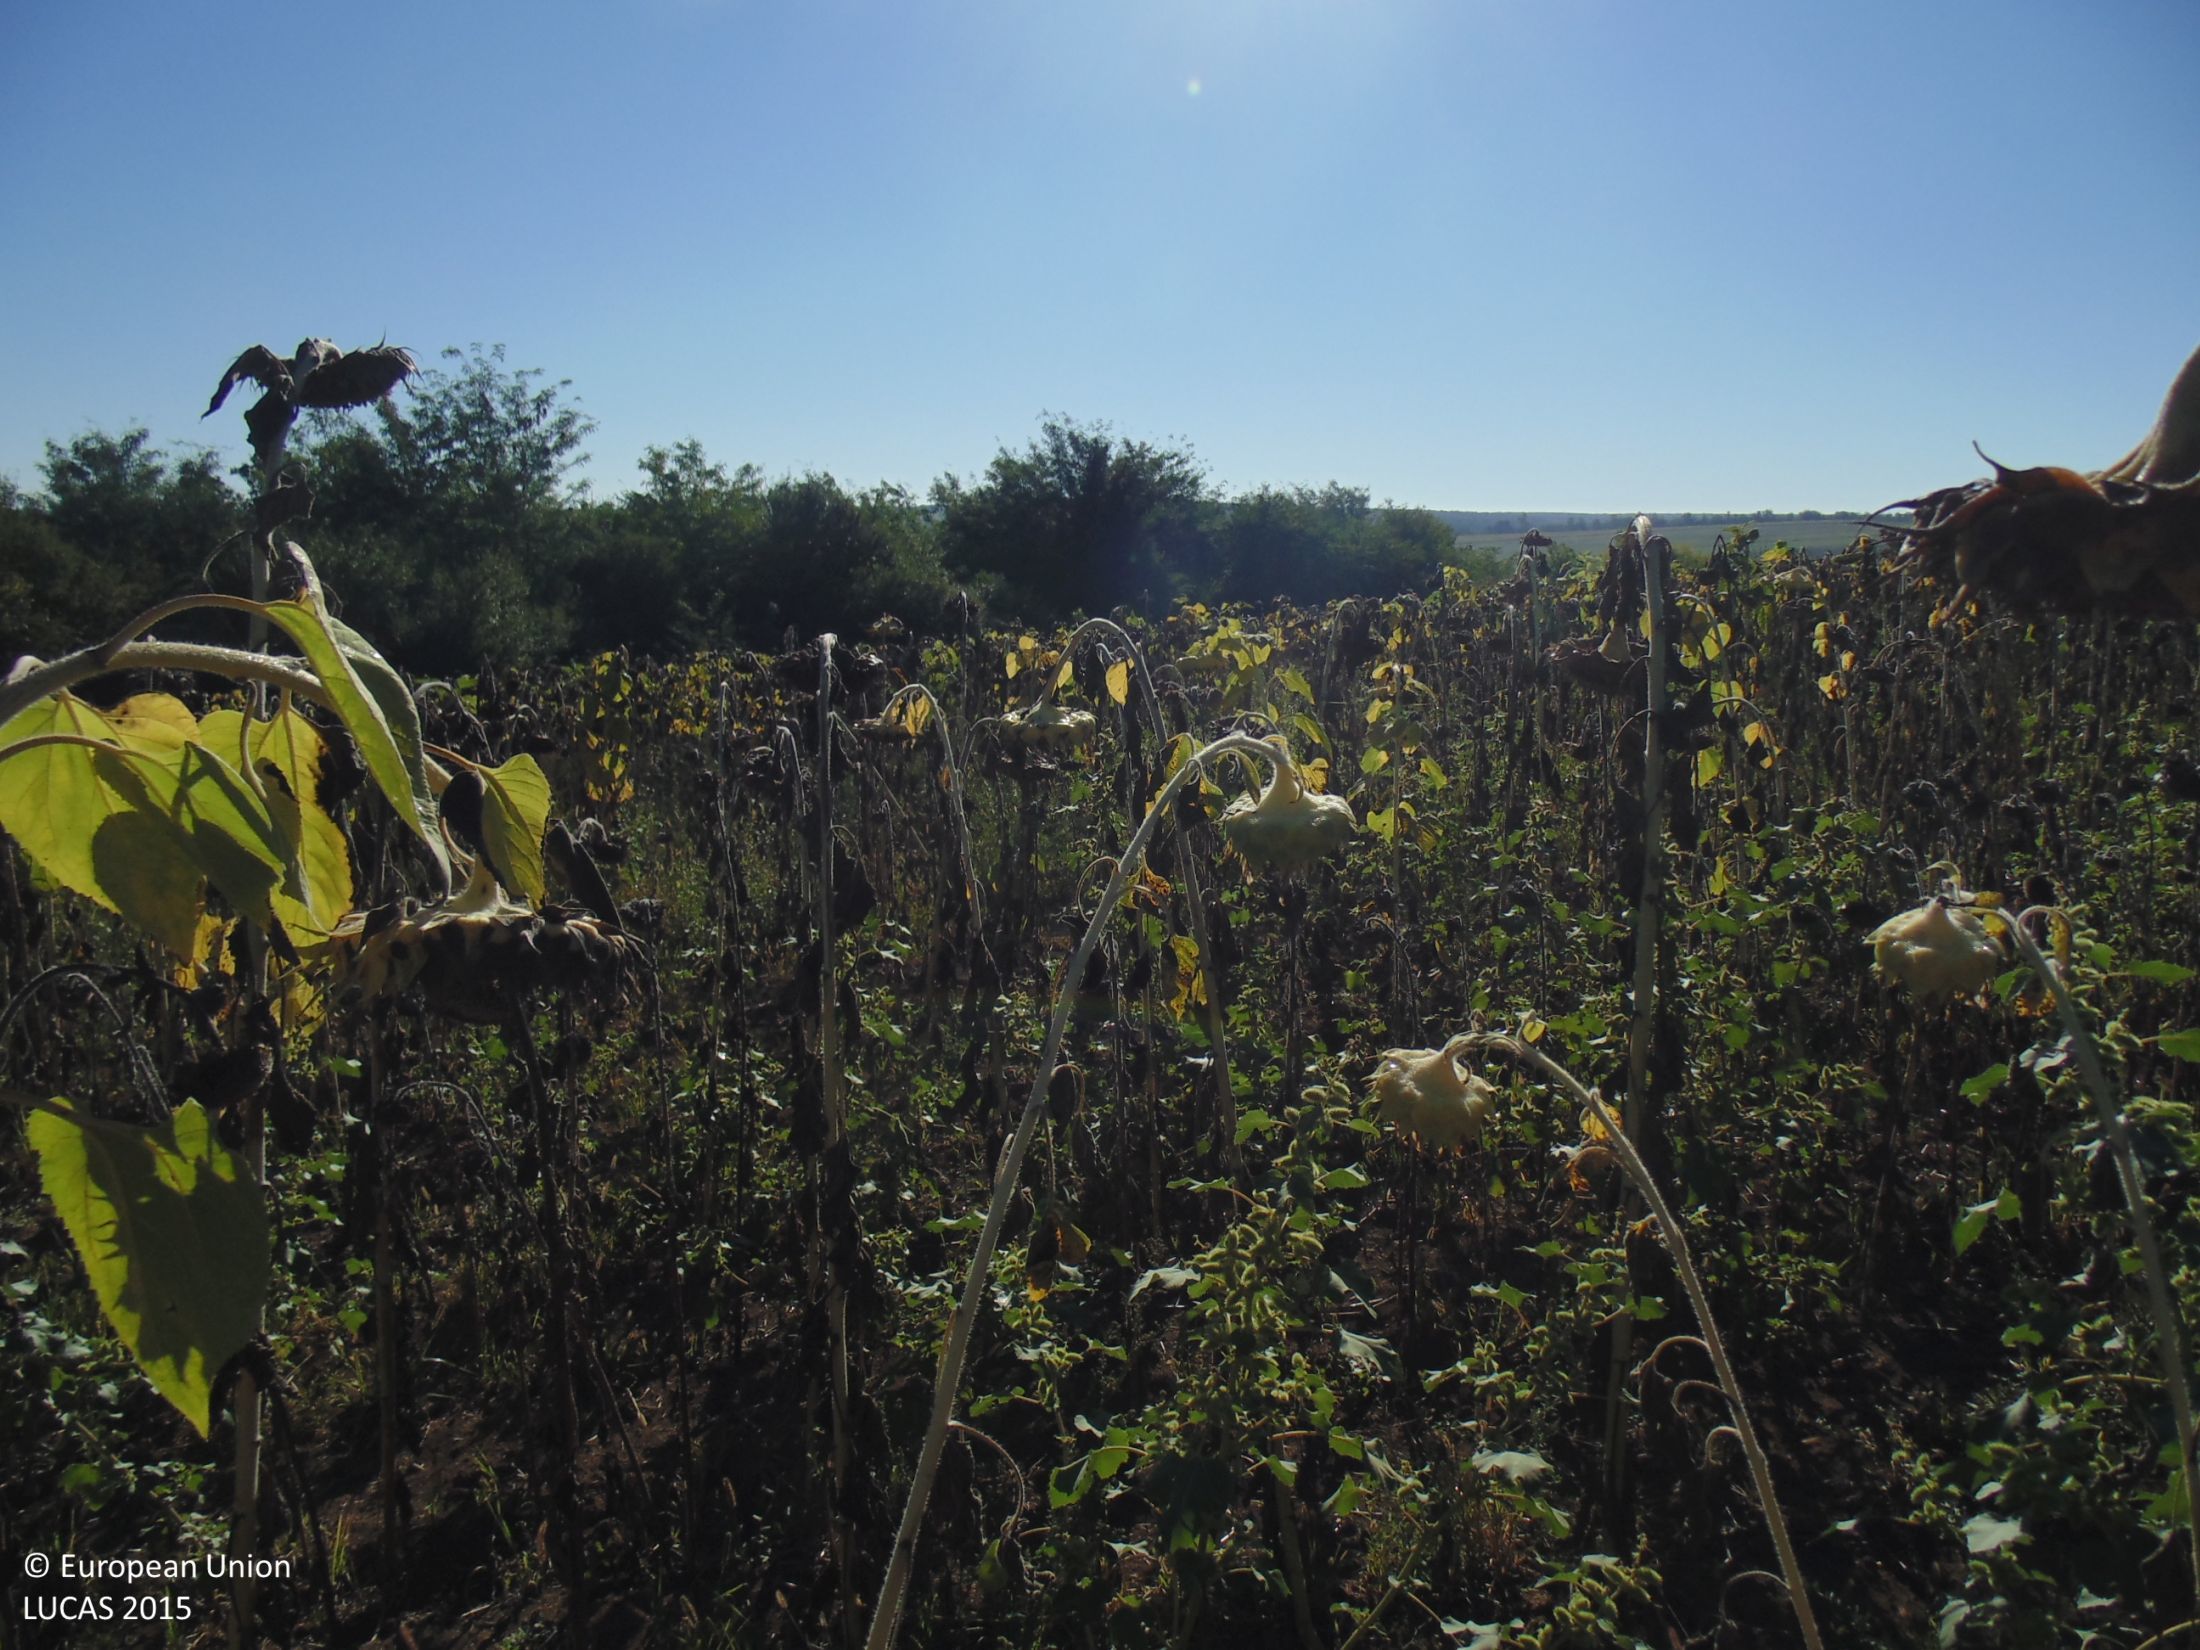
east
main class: Cropland
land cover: Sunflower
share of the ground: > 75 %
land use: Agriculture (excluding fallow land and kitchen gardens)
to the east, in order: Sunflower; Grass margins; Broadleaved woodland
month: September
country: BG
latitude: 43.7612
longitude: 27.2307
